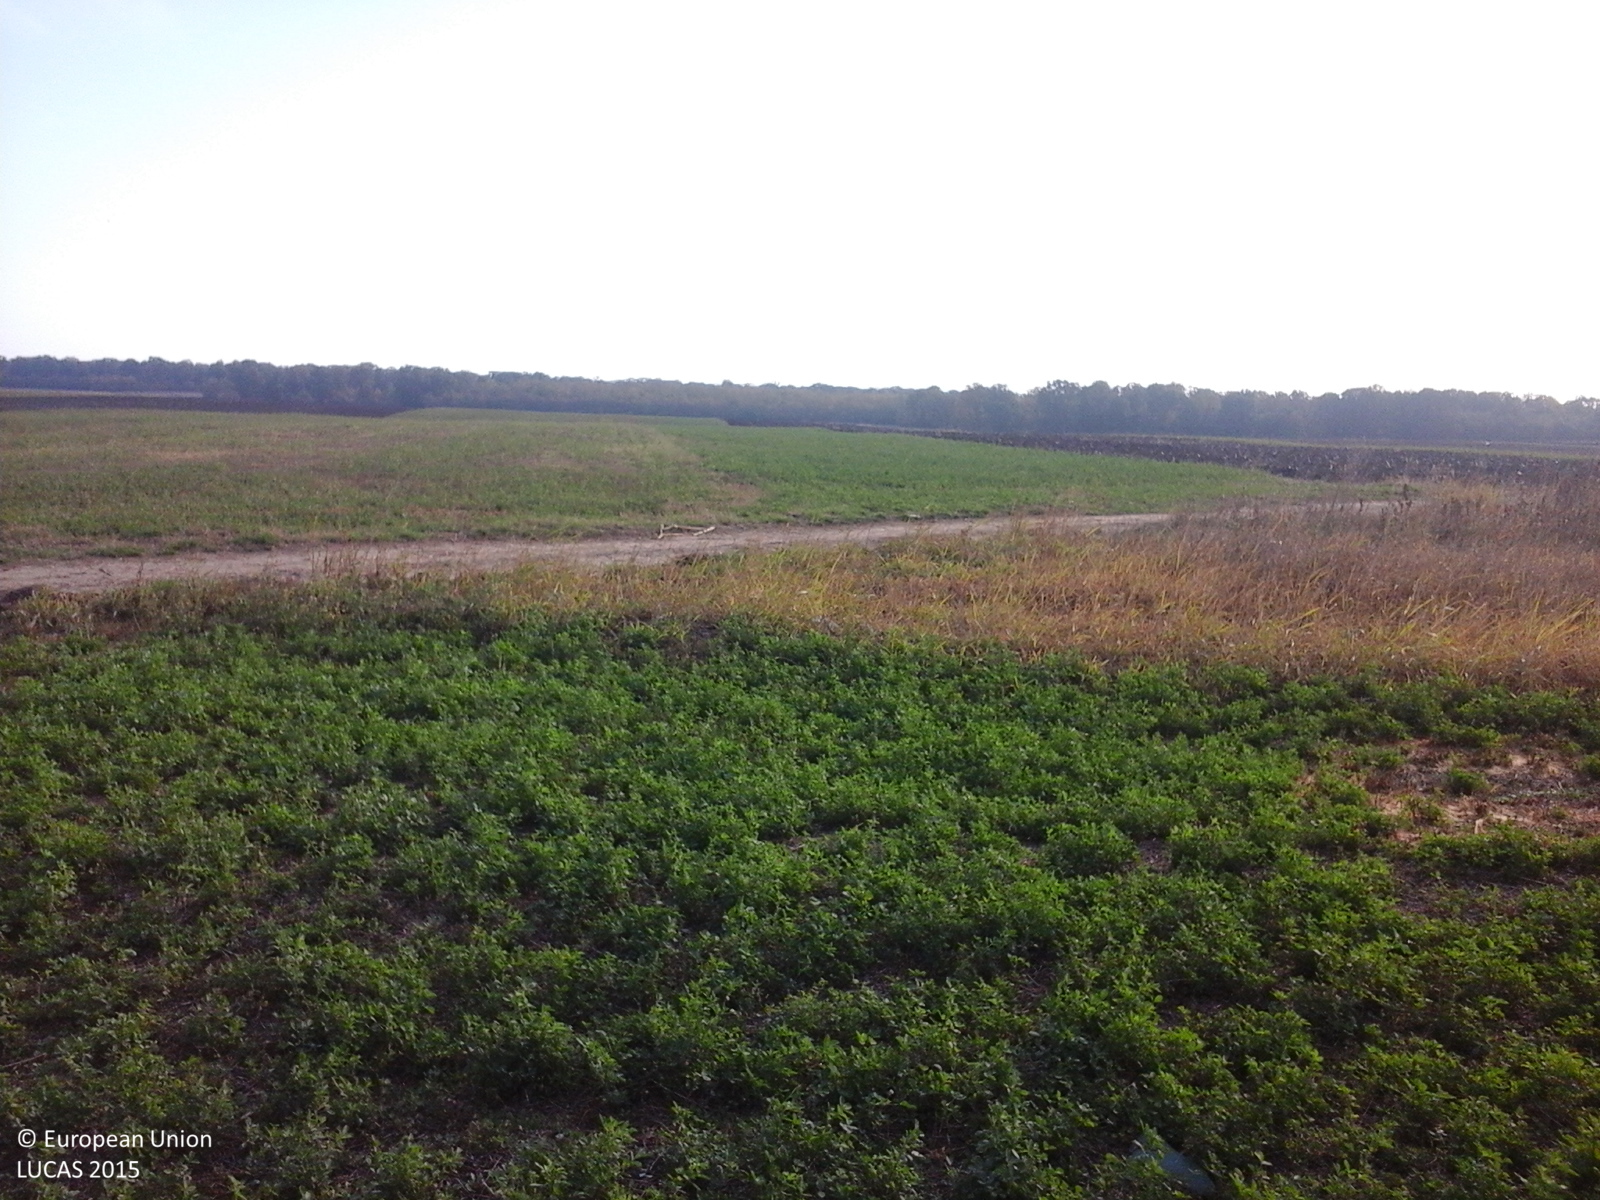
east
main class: Cropland
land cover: Lucerne
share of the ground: > 75 %
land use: Agriculture (excluding fallow land and kitchen gardens)
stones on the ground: < 10 %
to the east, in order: Lucerne; Grassland without tree/shrub cover; Electric lines; Grassland without tree/shrub cover; Tracks; Lucerne; Other bare soil
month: October
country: RO
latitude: 45.4775
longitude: 27.0916
